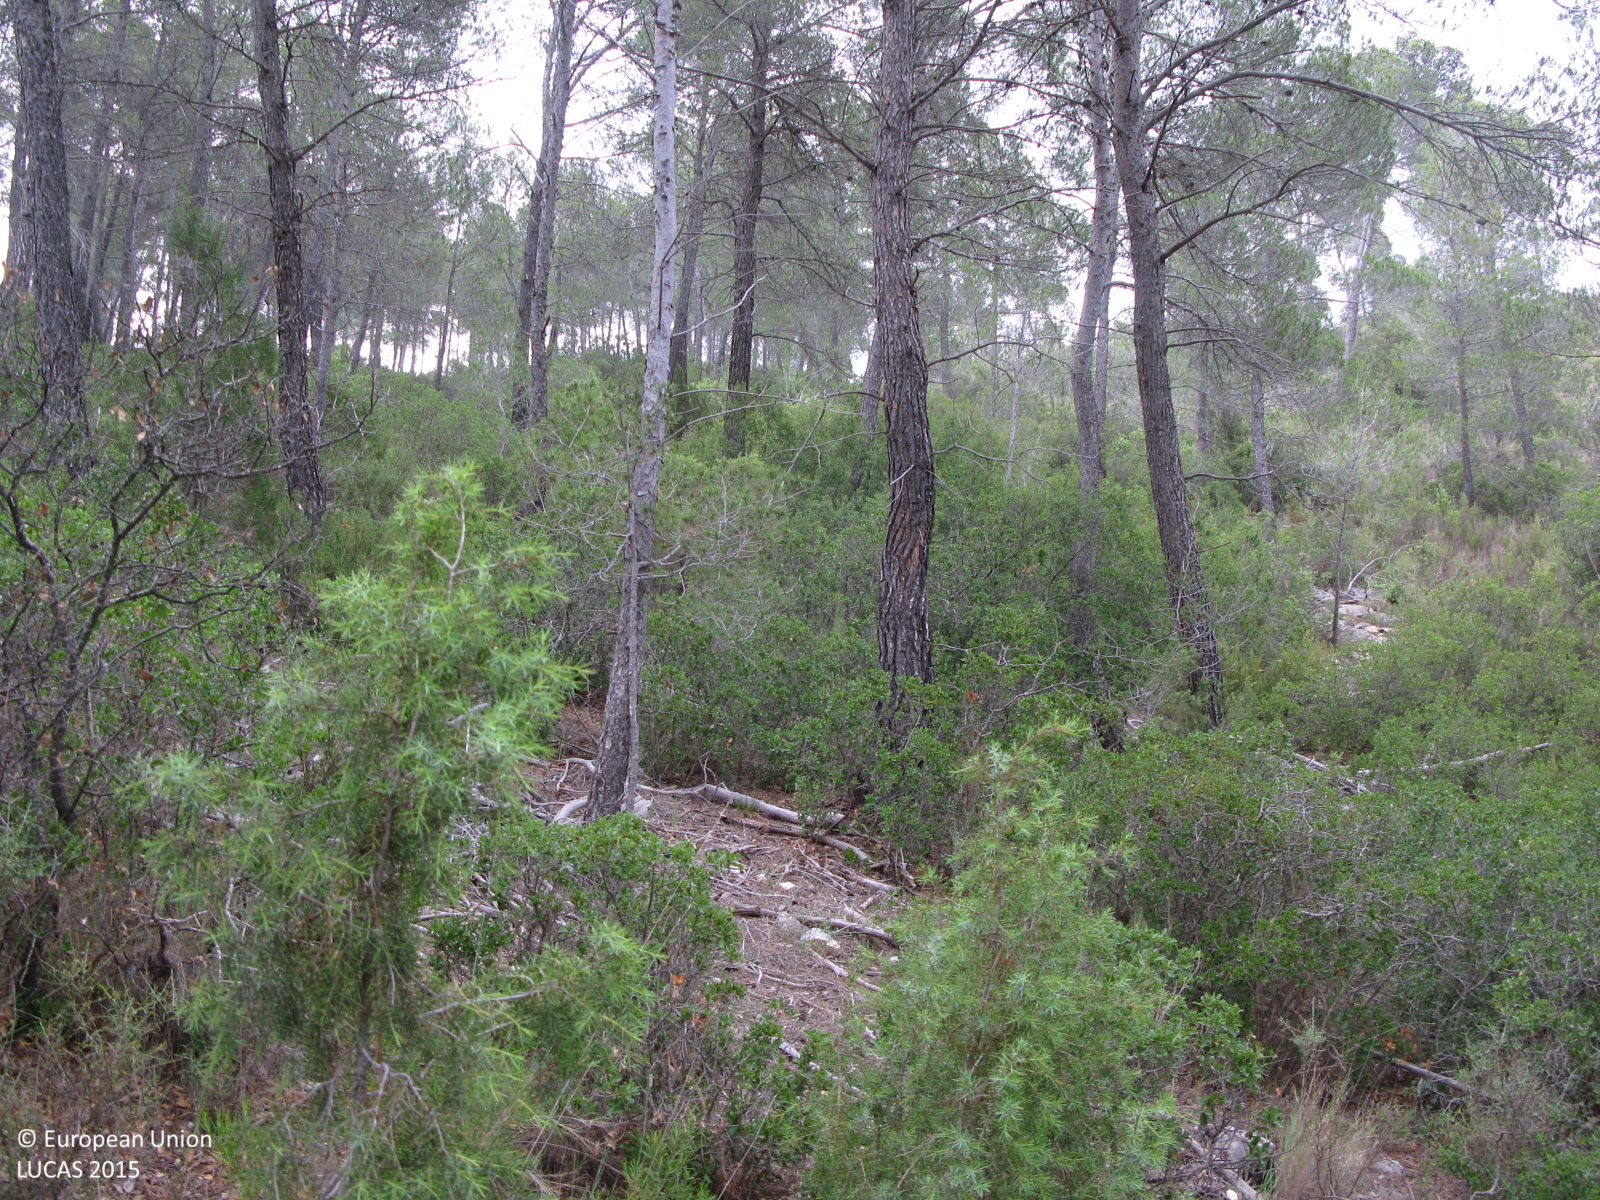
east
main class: Woodland
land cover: Pine dominated coniferous woodland
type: coniferous forest of the mediterranean region
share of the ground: 50 - 75 %
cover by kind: coniferous forest trees 50 %, shrubs 30 %, herbaceous plants 15 %, consolidated bare surface 5 %
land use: Forestry
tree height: > 5 m
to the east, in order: Pine dominated coniferous woodland
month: June
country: ES
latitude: 39.8852
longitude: -1.1501
